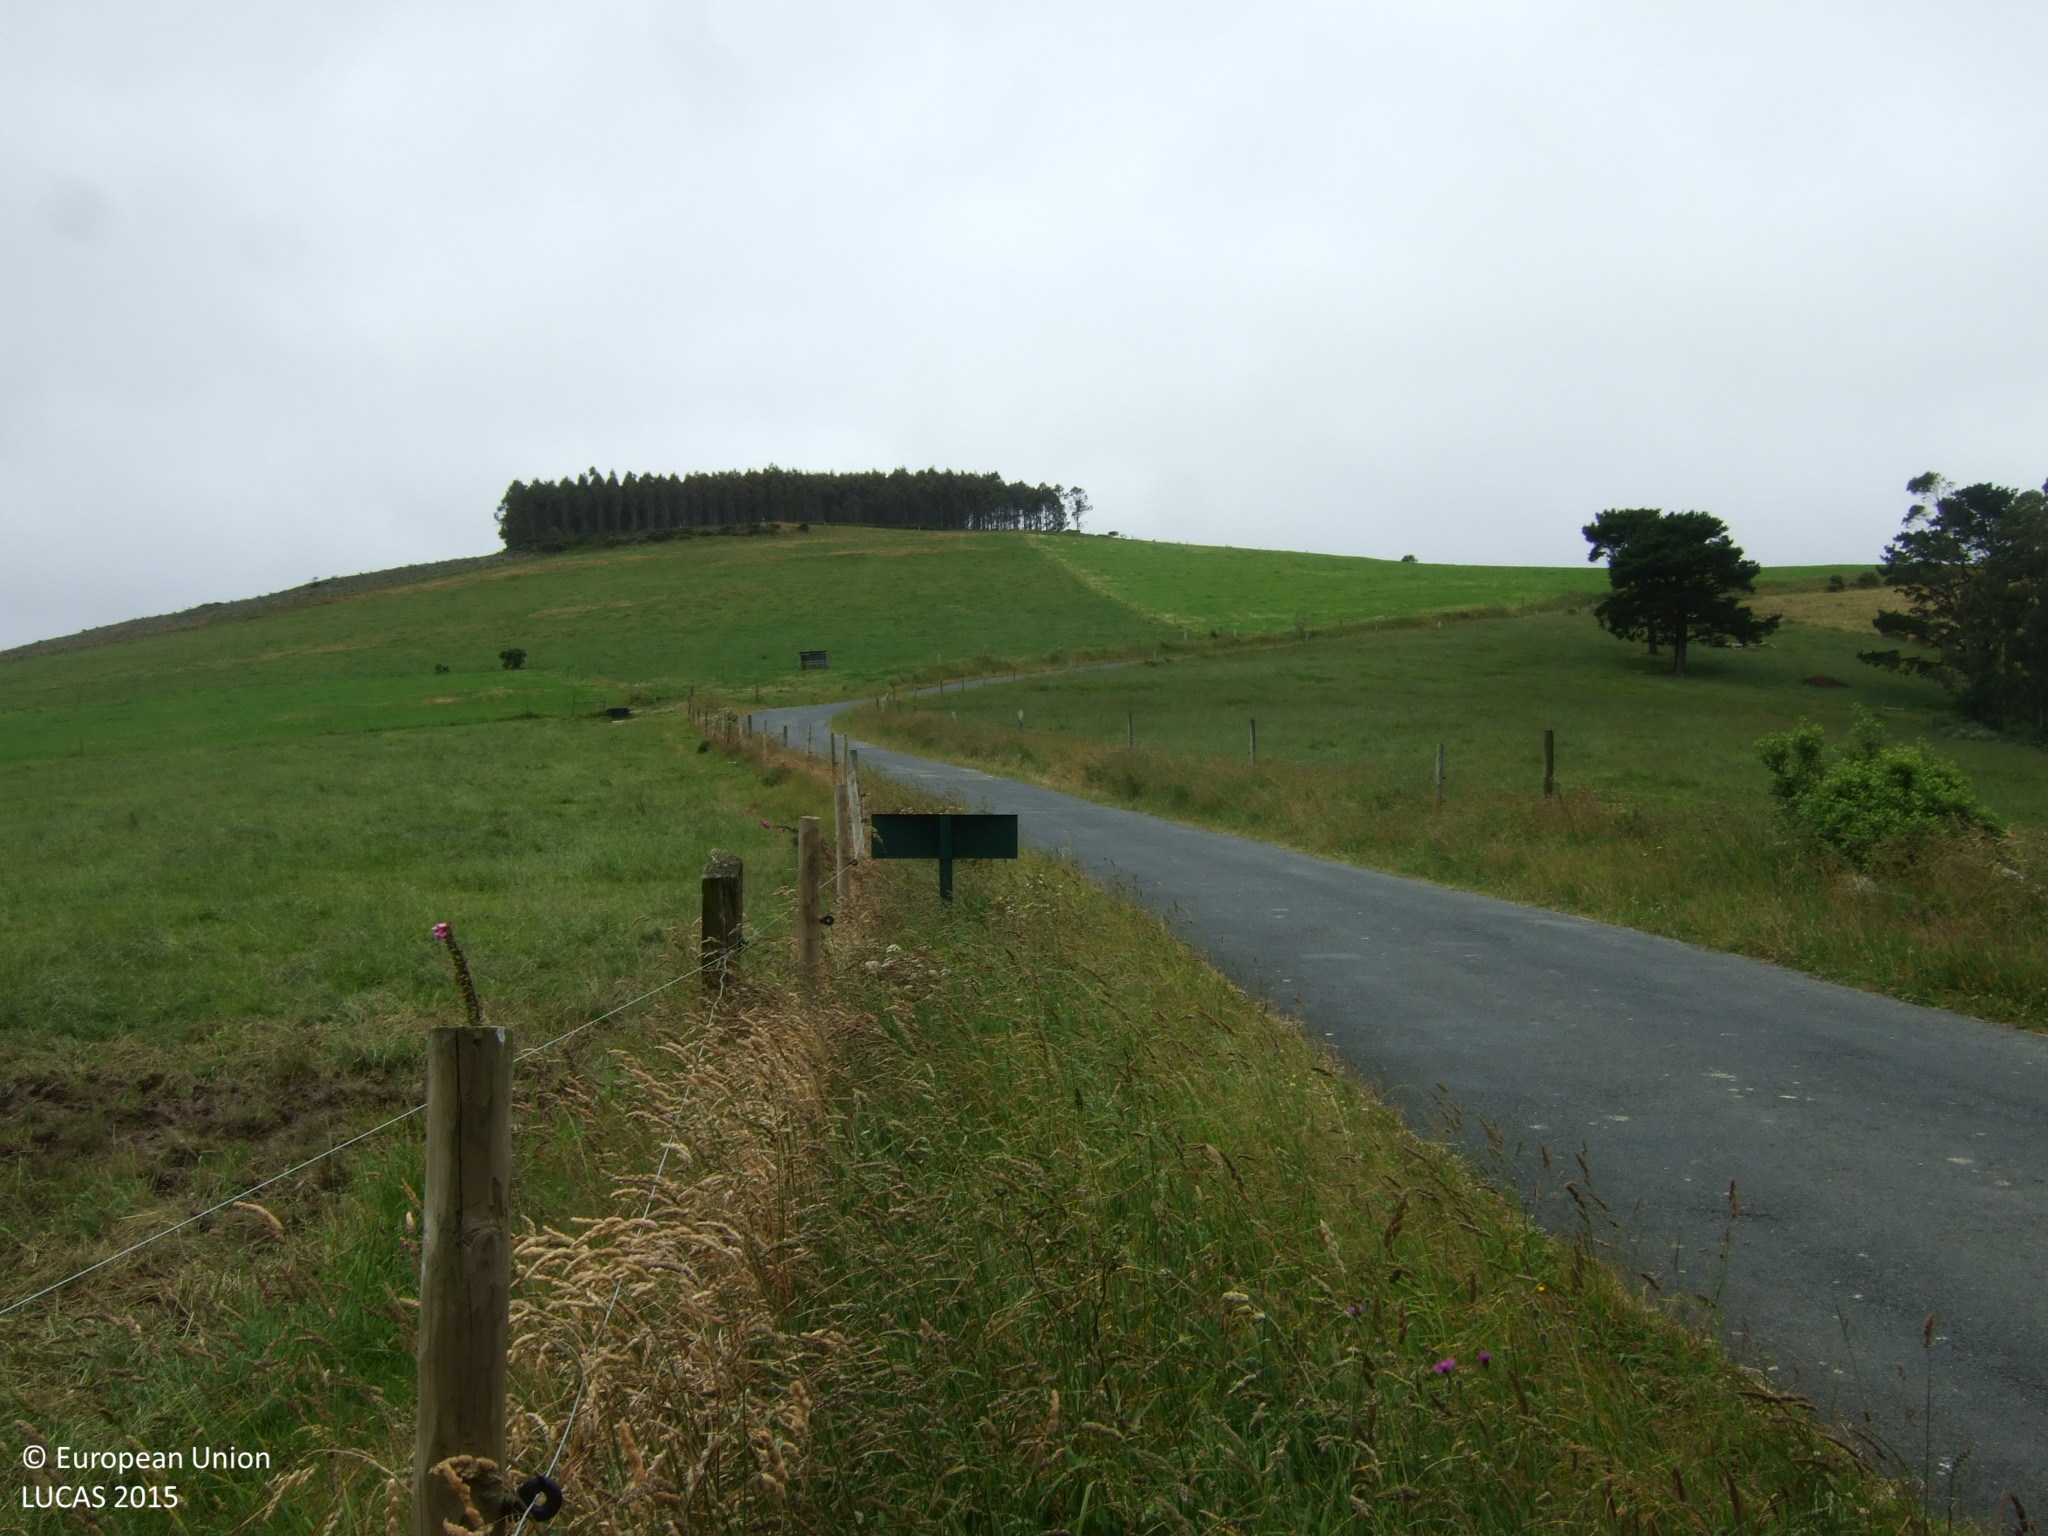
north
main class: Grassland
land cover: Grassland without tree/shrub cover
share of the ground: > 75 %
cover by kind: herbaceous plants 100 %
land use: Agriculture (excluding fallow land and kitchen gardens)
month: June
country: ES
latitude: 43.5997
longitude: -7.8445
